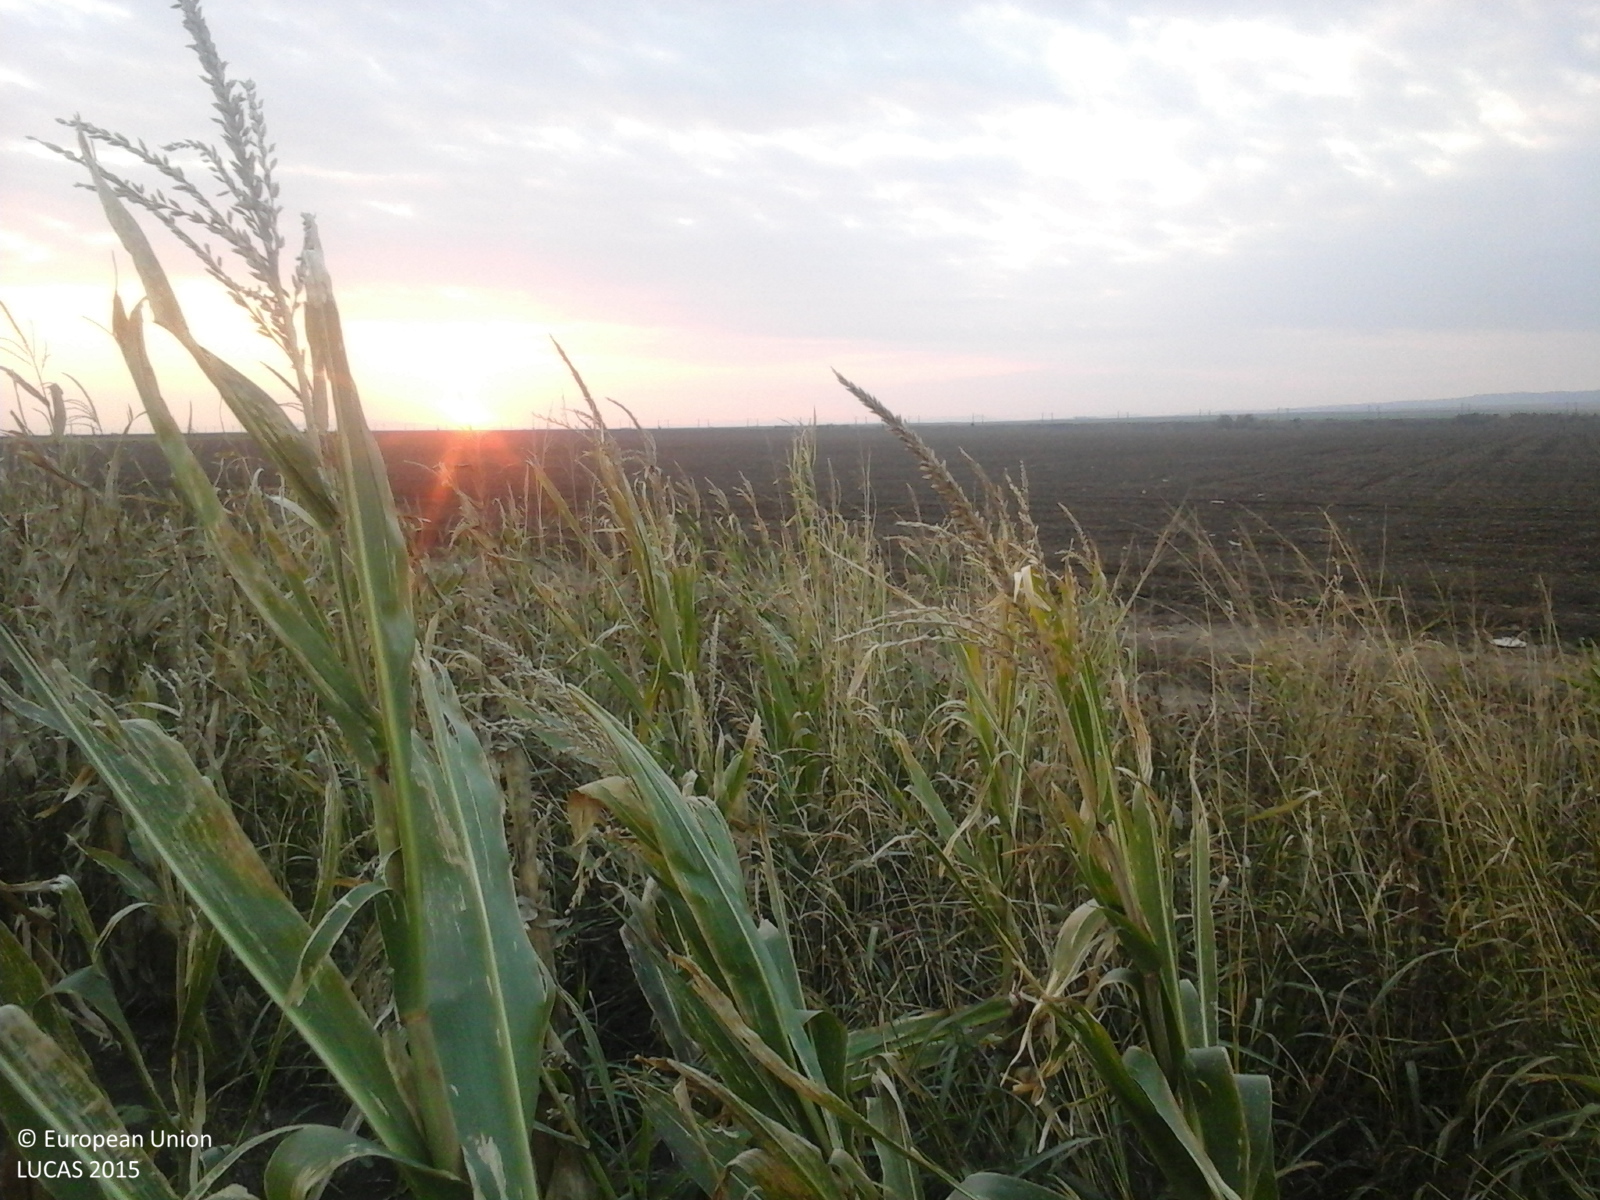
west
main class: Cropland
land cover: Maize
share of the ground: > 75 %
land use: Agriculture (excluding fallow land and kitchen gardens)
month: October
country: RO
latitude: 45.2542
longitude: 26.9947
